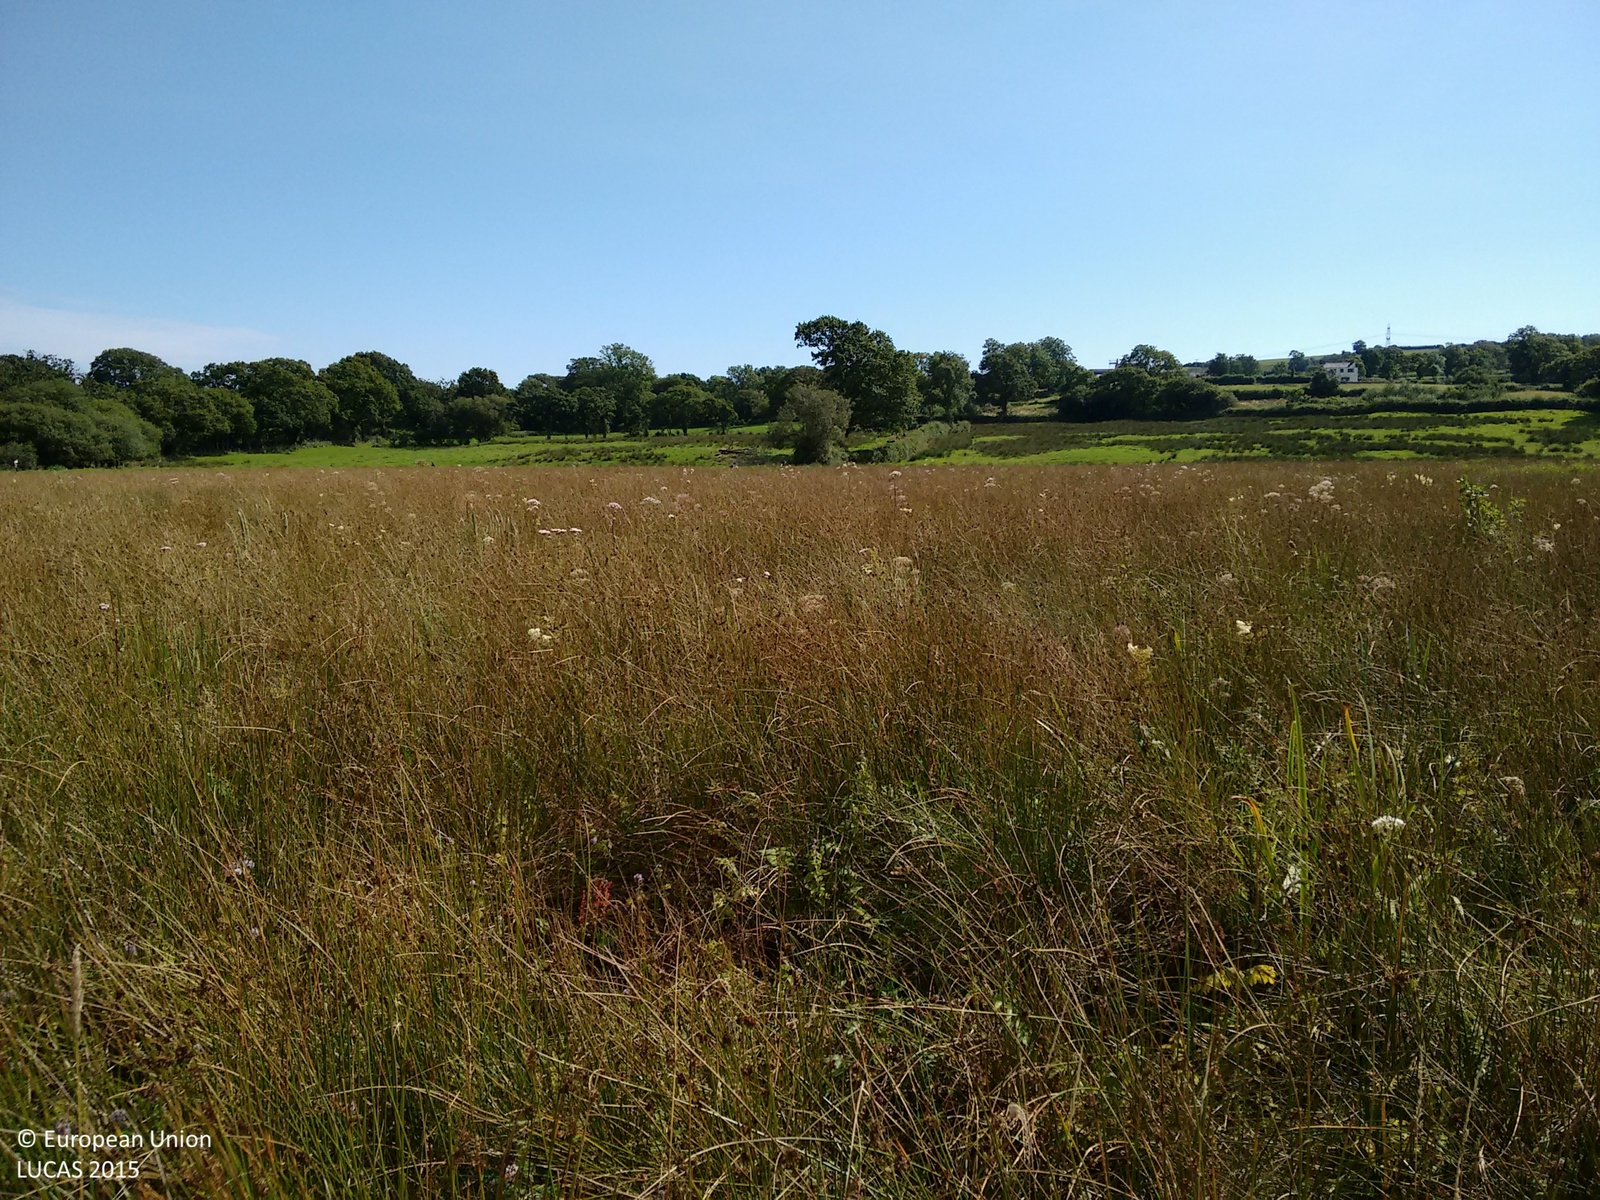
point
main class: Grassland
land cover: Grassland without tree/shrub cover
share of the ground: > 75 %
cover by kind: herbaceous plants 95 %, unconsolidated bare surface 5 %
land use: Agriculture (excluding fallow land and kitchen gardens)
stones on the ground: < 10 %
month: August
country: GB
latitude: 51.8087
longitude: -4.5081
